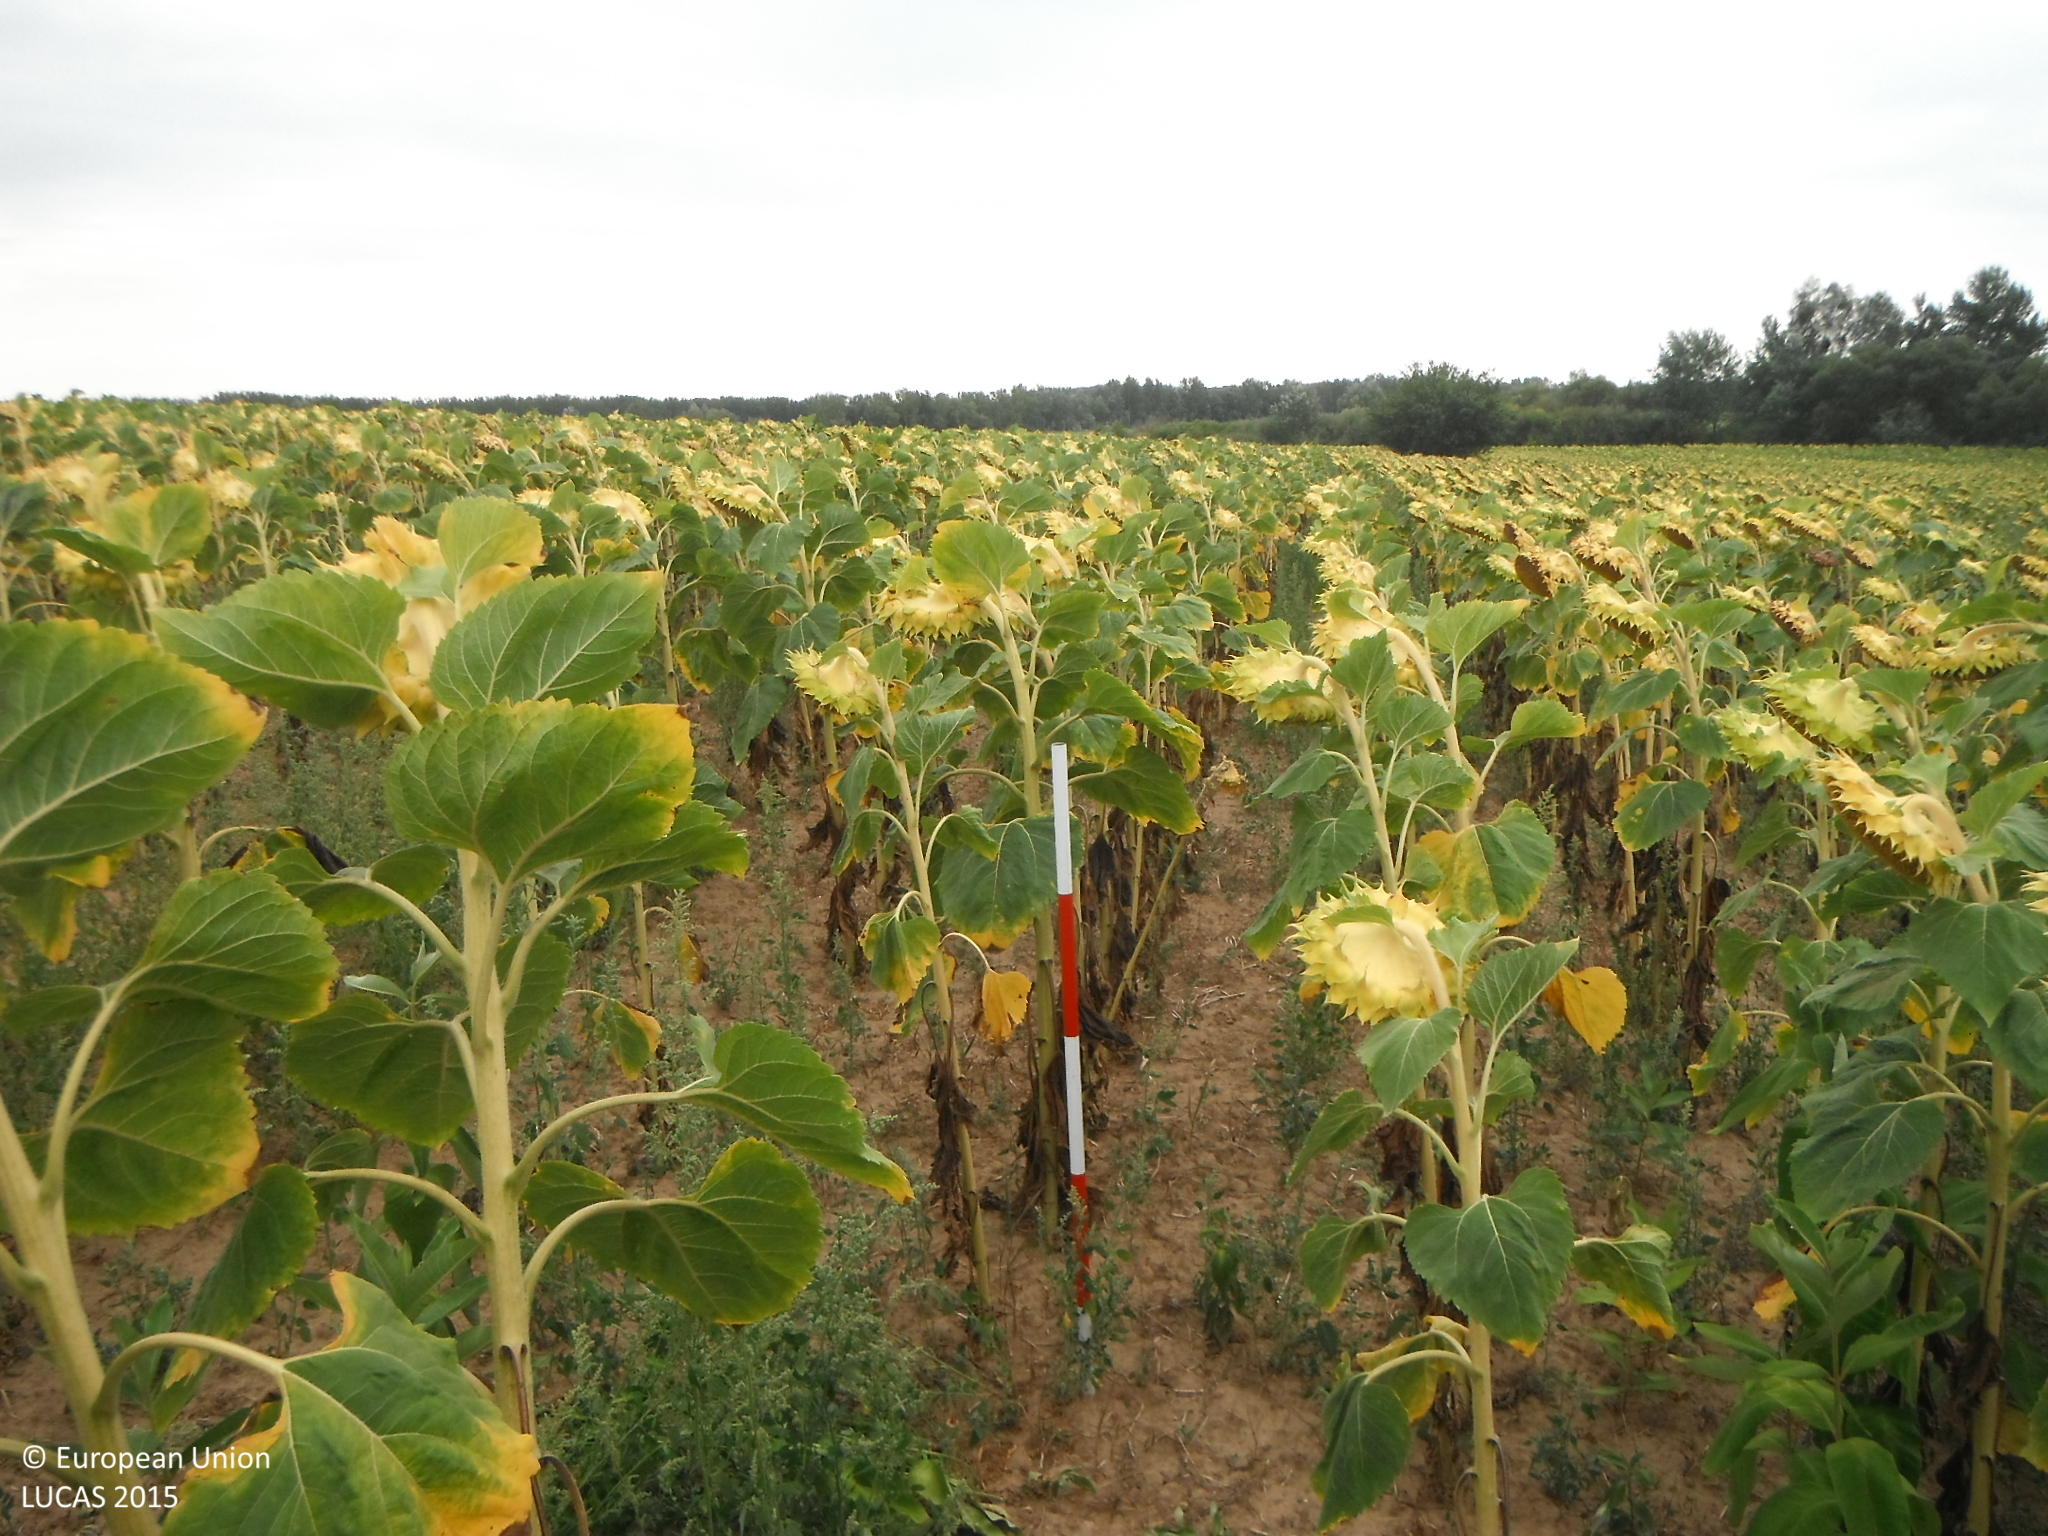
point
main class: Cropland
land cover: Sunflower
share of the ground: > 75 %
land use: Agriculture (excluding fallow land and kitchen gardens)
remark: Harvested field
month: August
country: SK
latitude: 48.4775
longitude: 21.8068
